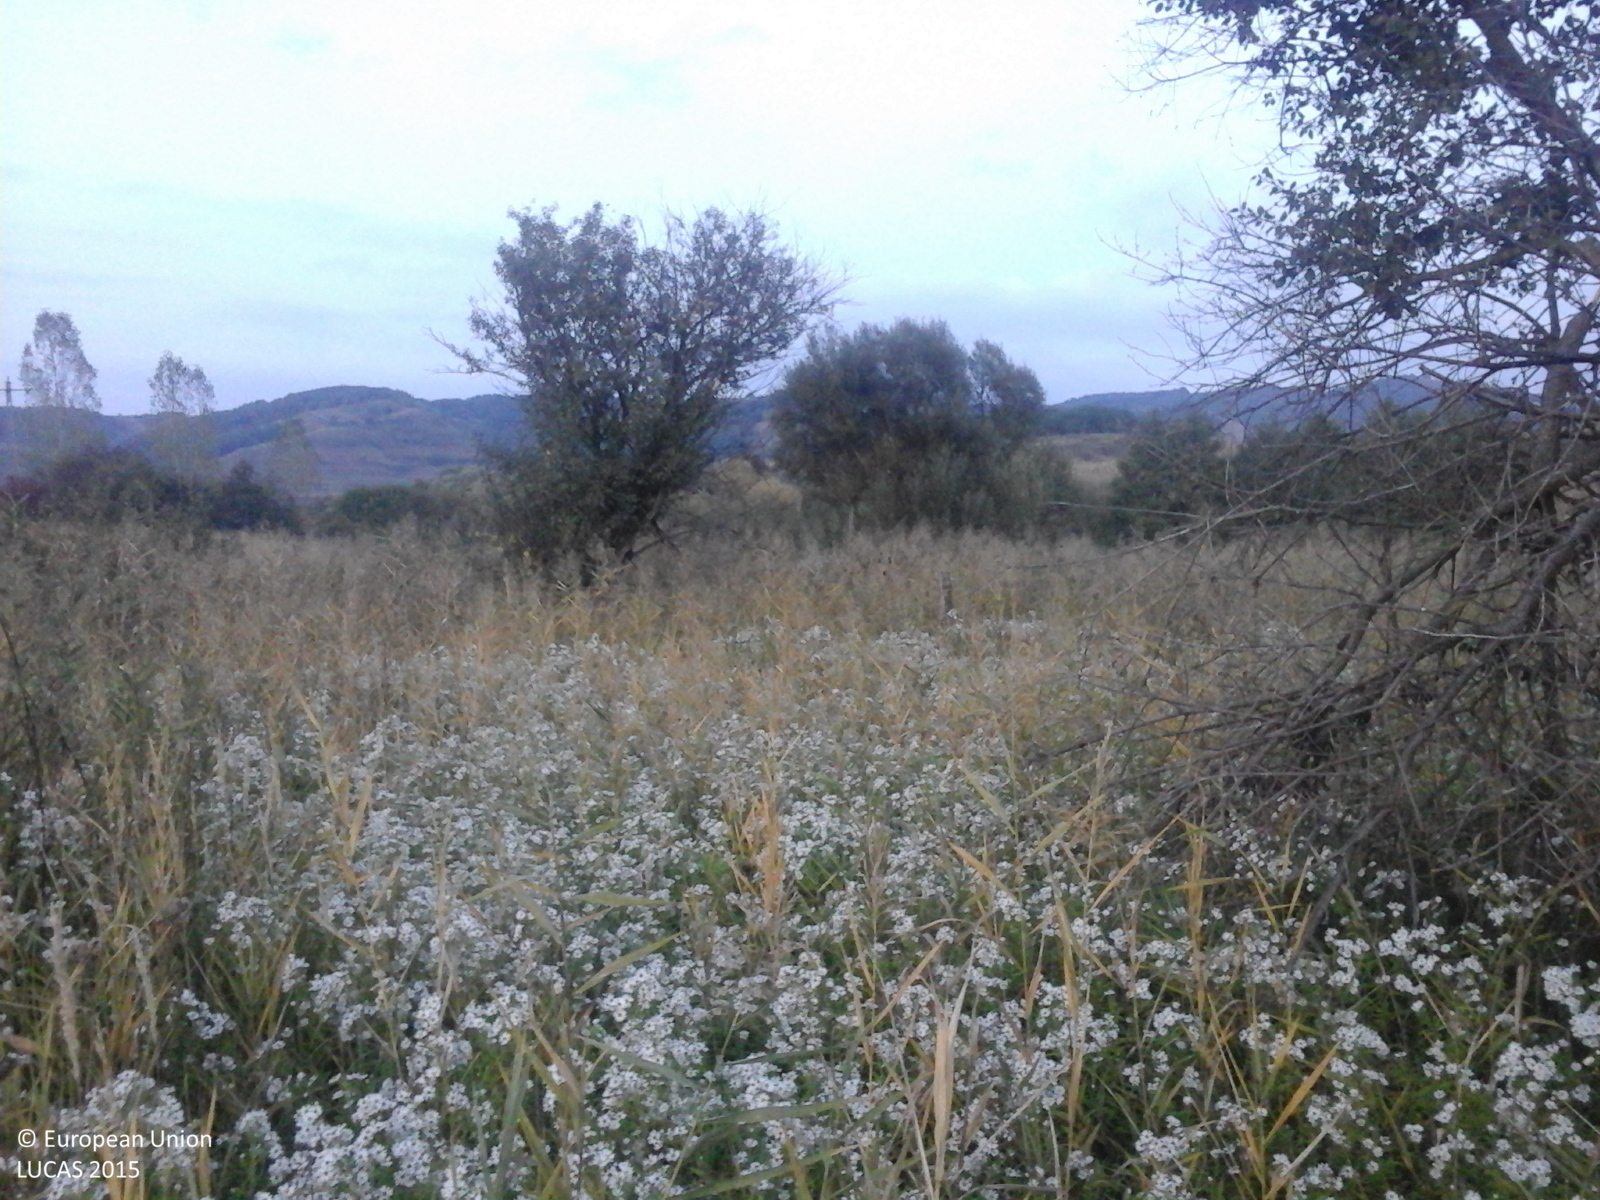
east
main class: Grassland
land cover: Spontaneously vegetated surfaces
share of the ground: > 75 %
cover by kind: herbaceous plants 100 %
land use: Fallow land
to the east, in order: Spontaneously vegetated surfaces; Grassland with sparse tree/shrub cover; Tracks; Shrubland without tree cover; Tracks; Lucerne; Maize; Spontaneously vegetated surfaces; Maize
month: October
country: RO
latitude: 46.0023
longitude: 24.1910
